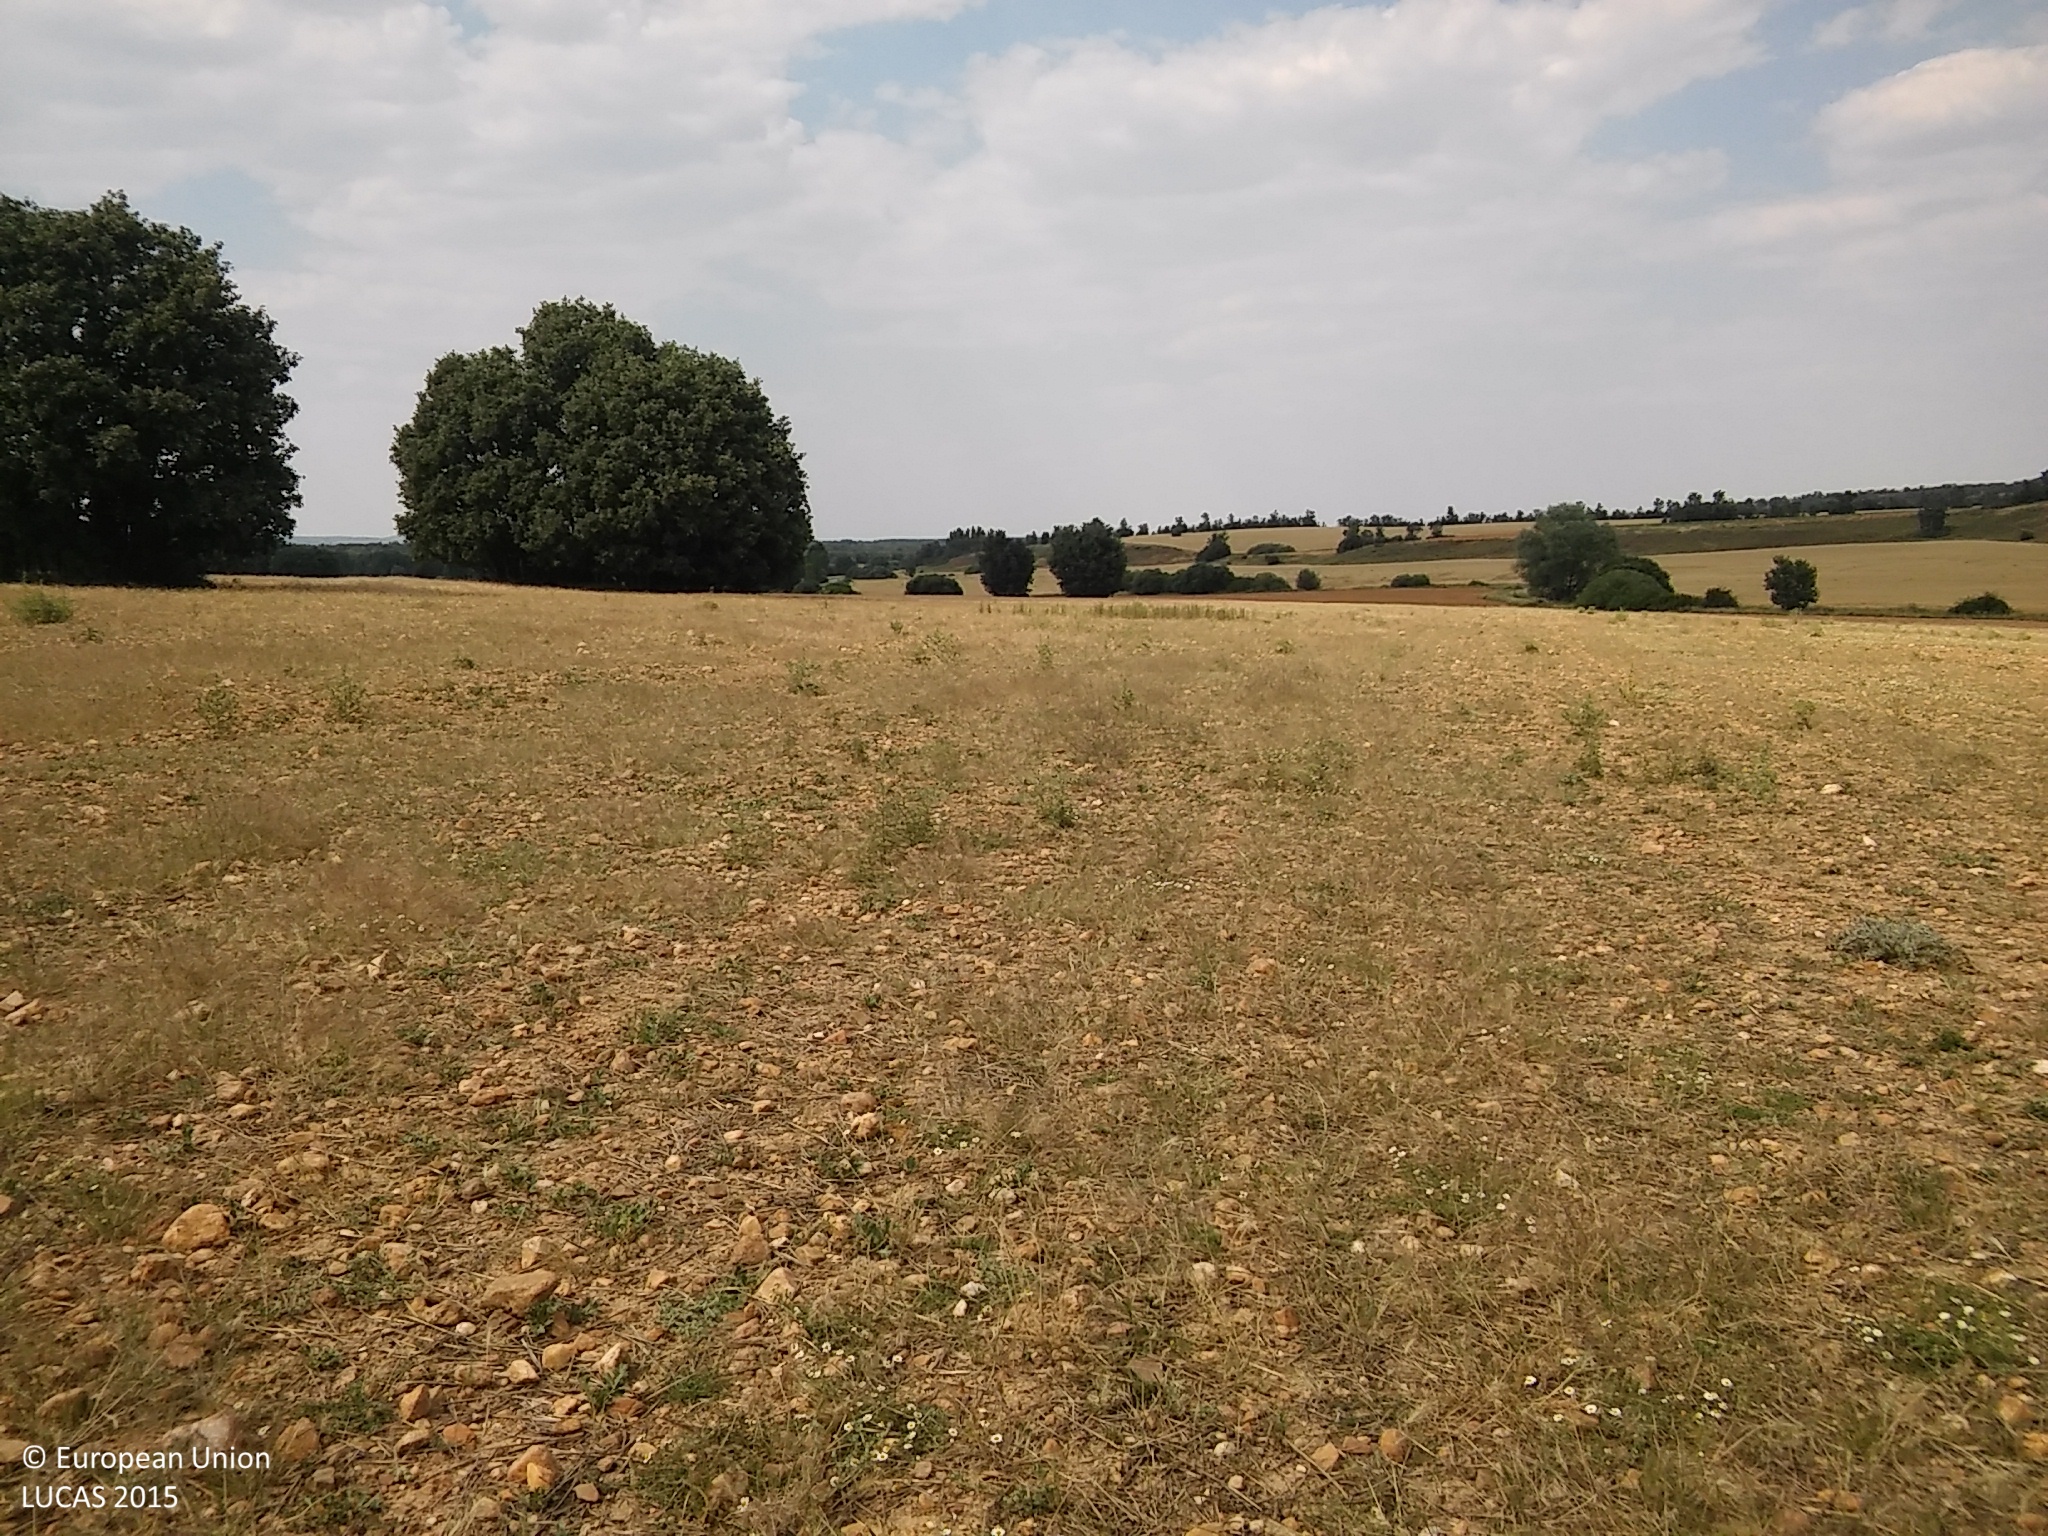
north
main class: Grassland
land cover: Spontaneously vegetated surfaces
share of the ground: 50 - 75 %
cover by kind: herbaceous plants 60 %, unconsolidated bare surface 40 %
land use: Agriculture (excluding fallow land and kitchen gardens)
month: June
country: ES
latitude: 41.3315
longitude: -3.5850
